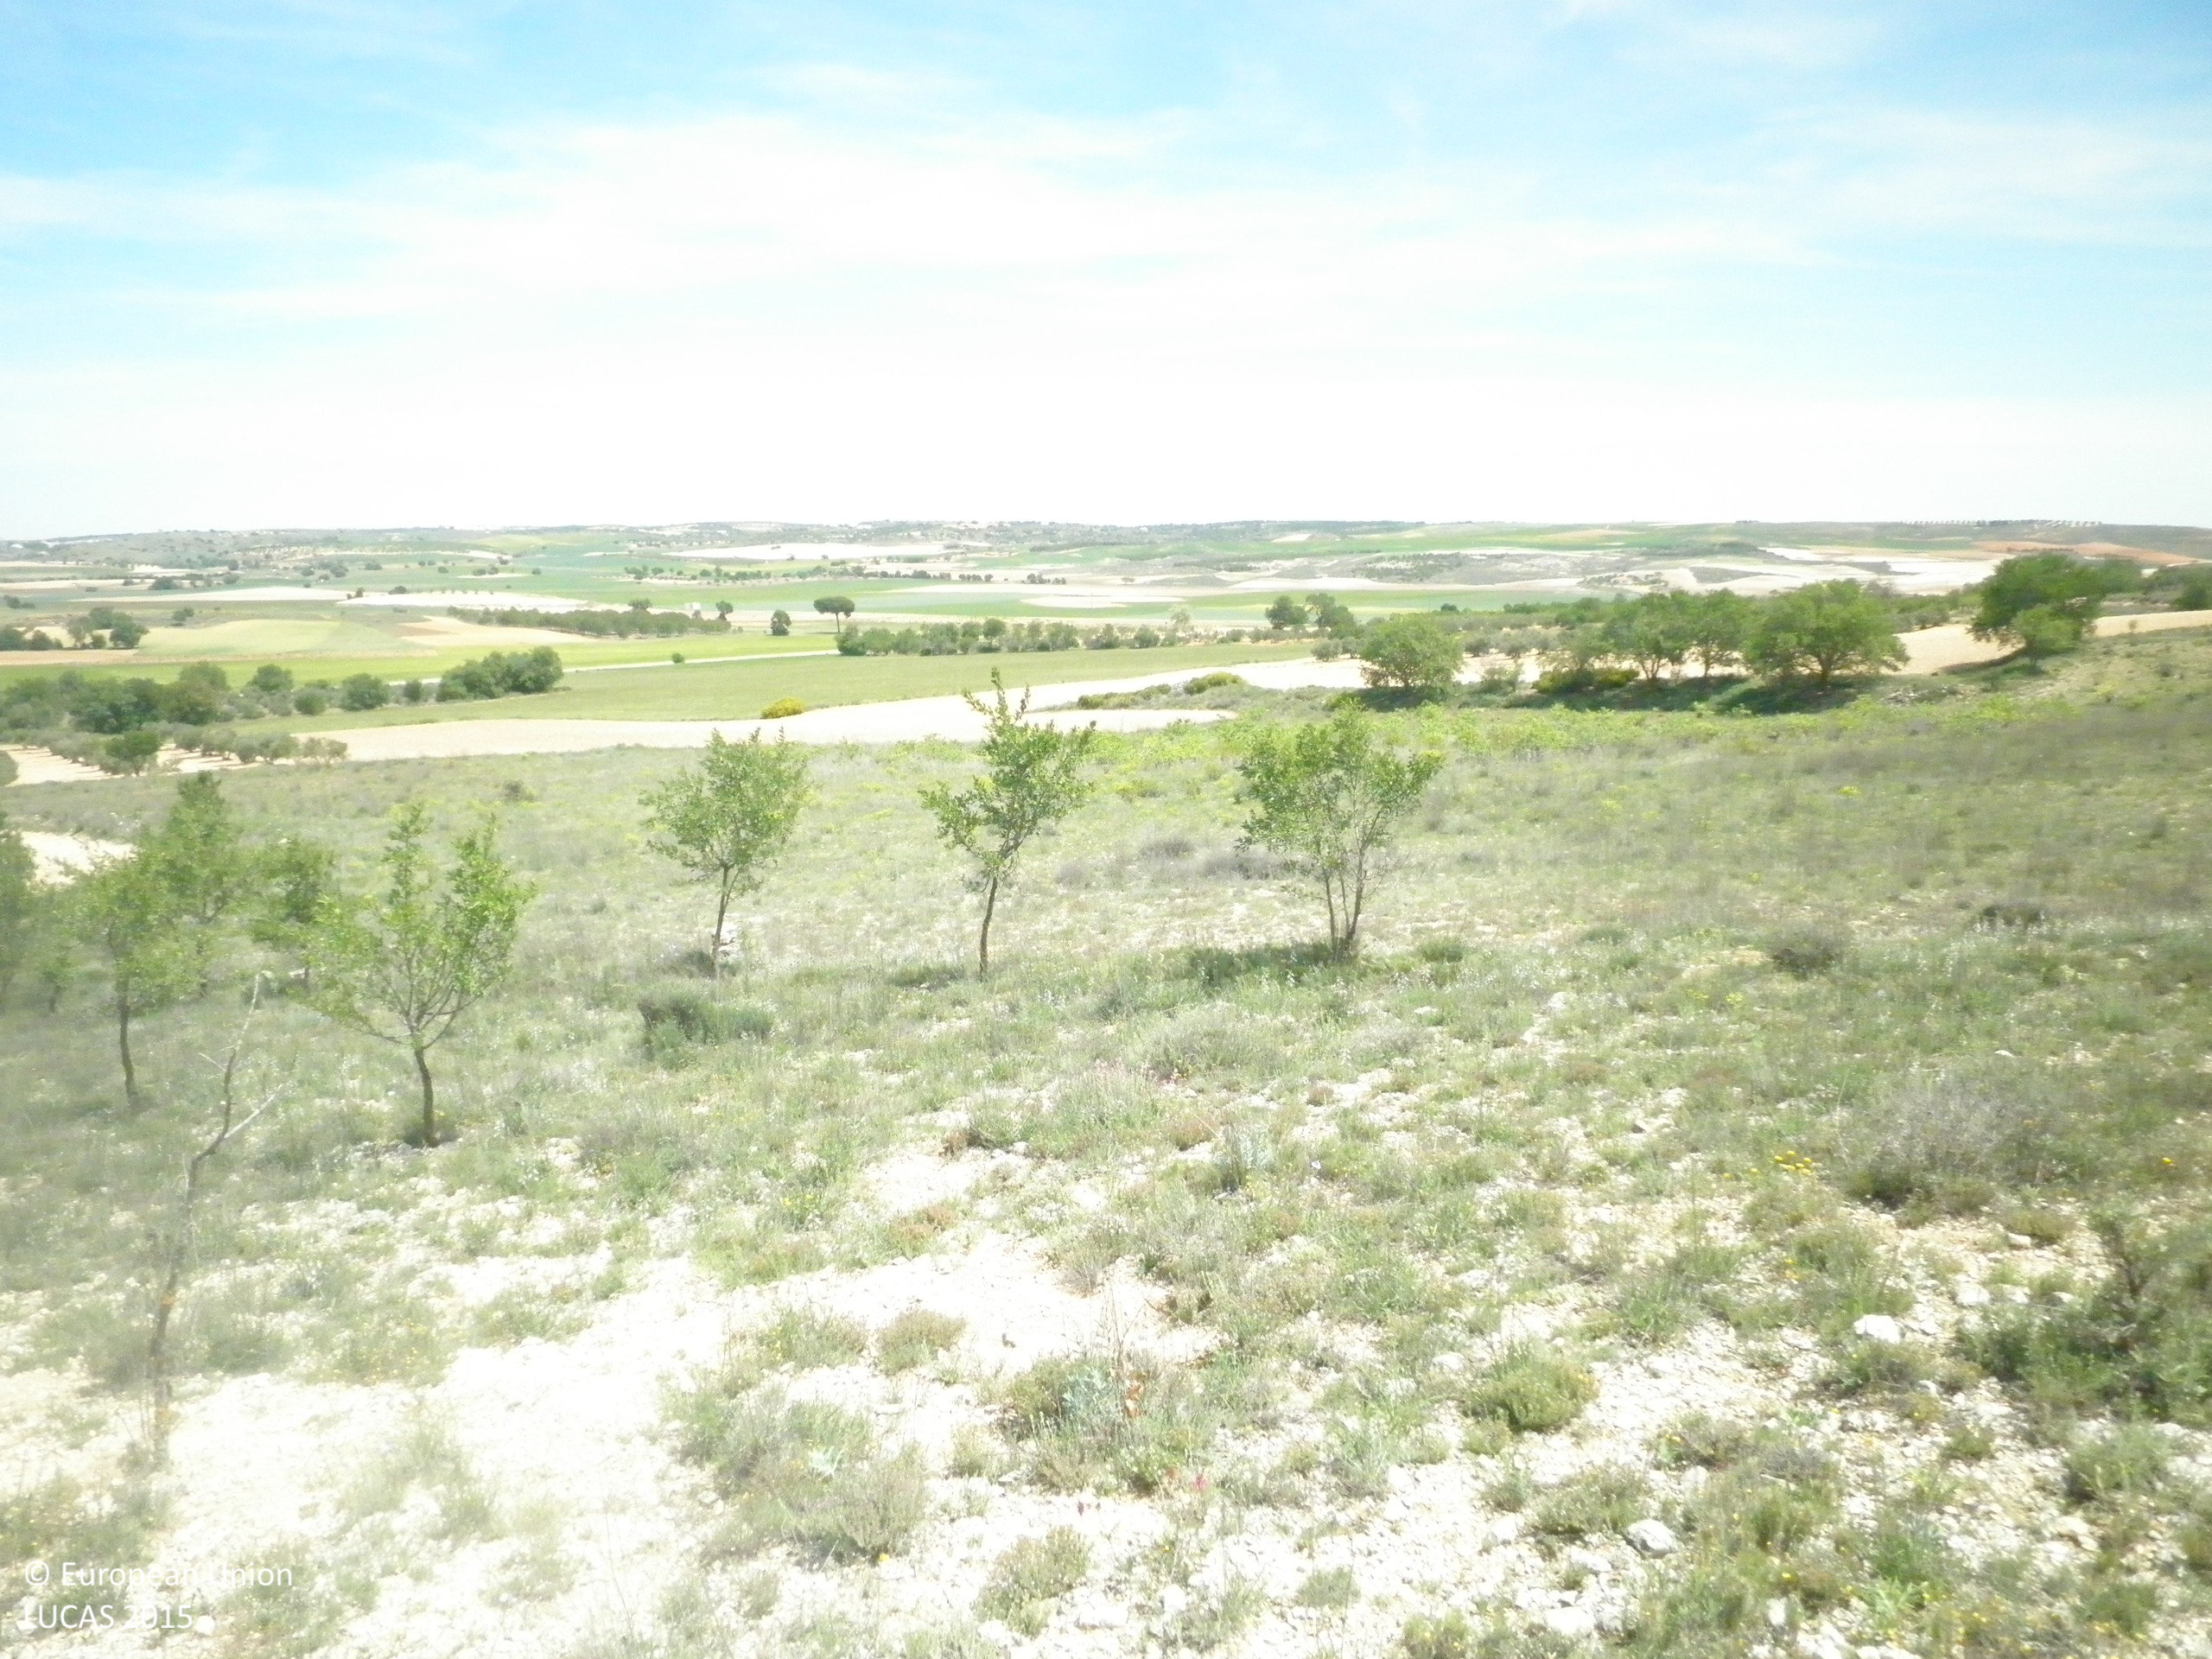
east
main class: Shrubland
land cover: Shrubland with sparse tree cover
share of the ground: 50 - 75 %
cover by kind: unconsolidated bare surface 45 %, shrubs 30 %, herbaceous plants 20 %, broadleaved forest trees 5 %
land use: Semi-natural and natural areas not in use
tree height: < 5 m
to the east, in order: Shrubland with sparse tree cover; Spontaneously vegetated surfaces; Vineyards; Grass margins; Other bare soil; Grass margins; Spontaneously vegetated surfaces
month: May
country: ES
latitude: 39.5824
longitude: -2.7174
